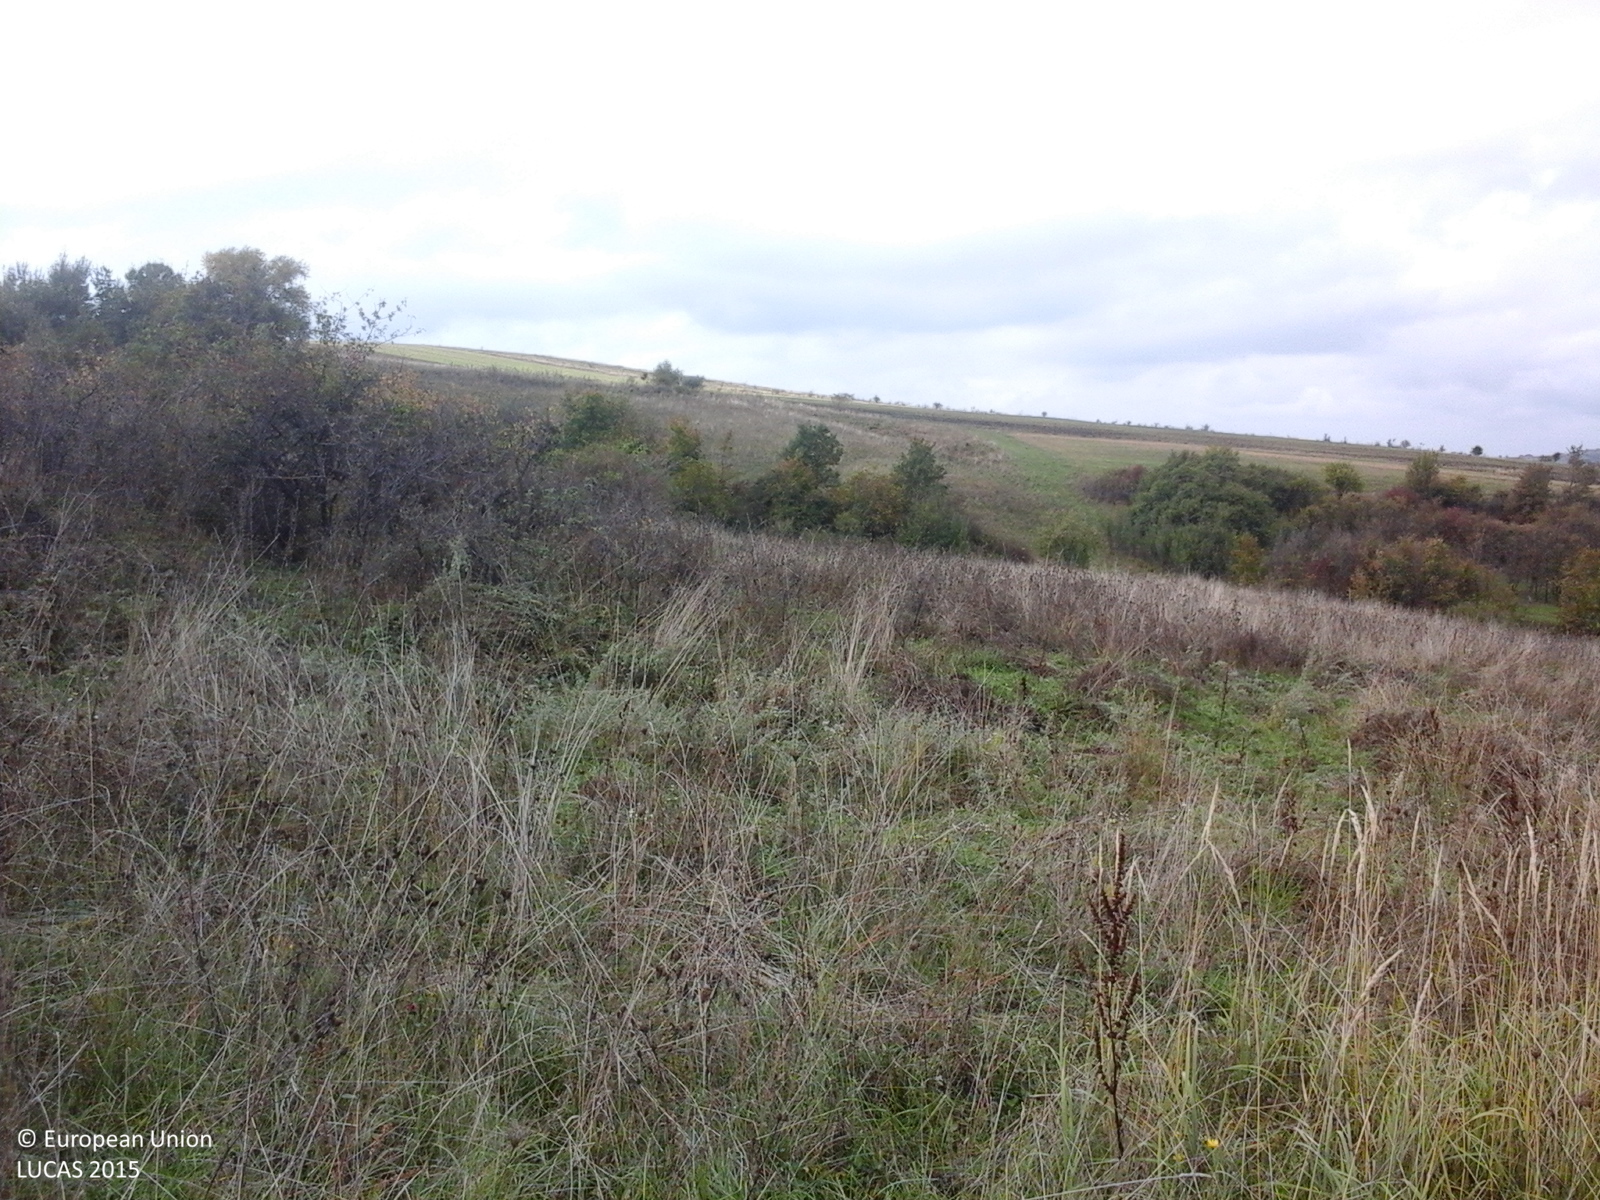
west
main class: Grassland
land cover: Grassland with sparse tree/shrub cover
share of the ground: > 75 %
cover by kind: herbaceous plants 90 %, broadleaved forest trees 5 %, shrubs 5 %
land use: Agriculture (excluding fallow land and kitchen gardens)
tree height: > 5 m
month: October
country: RO
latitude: 45.8543
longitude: 24.2042
